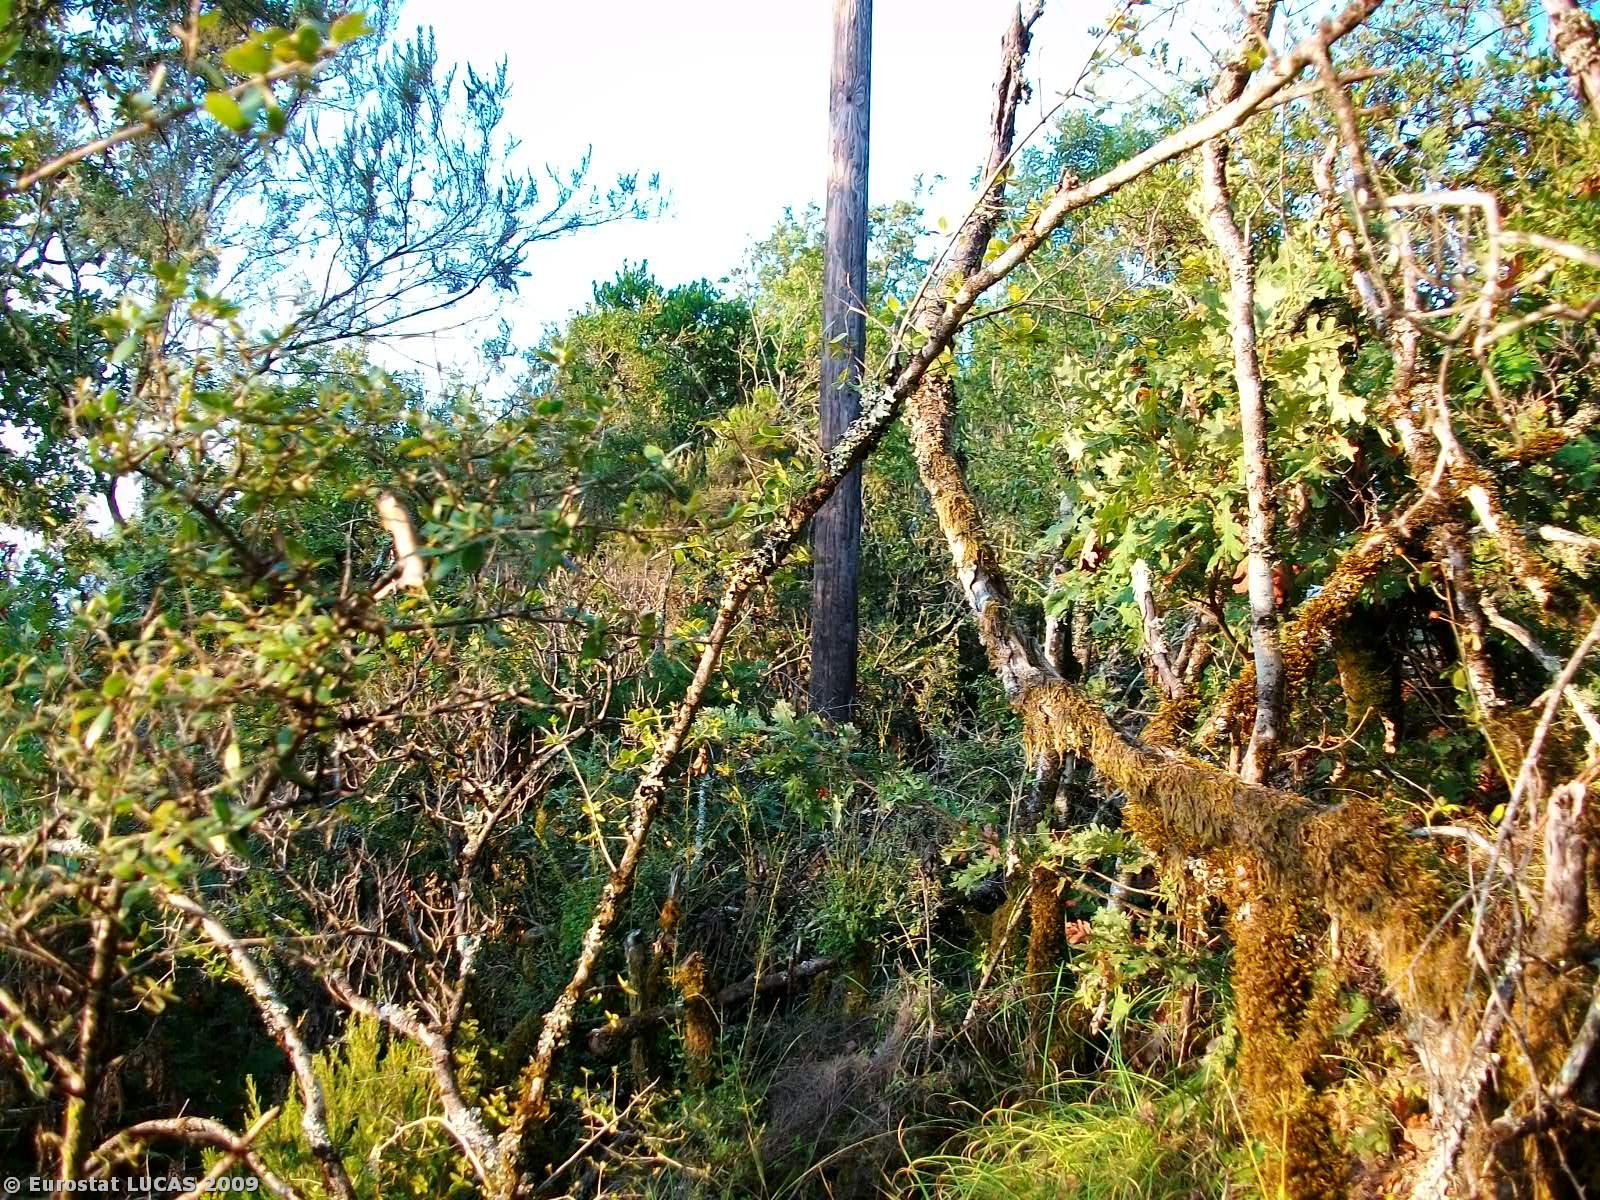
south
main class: Woodland
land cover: Broadleaved woodland
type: thermophilous deciduous forest
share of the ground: > 75 %
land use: Forestry
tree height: > 5 m
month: September
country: GR
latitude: 39.7039
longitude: 20.4853
